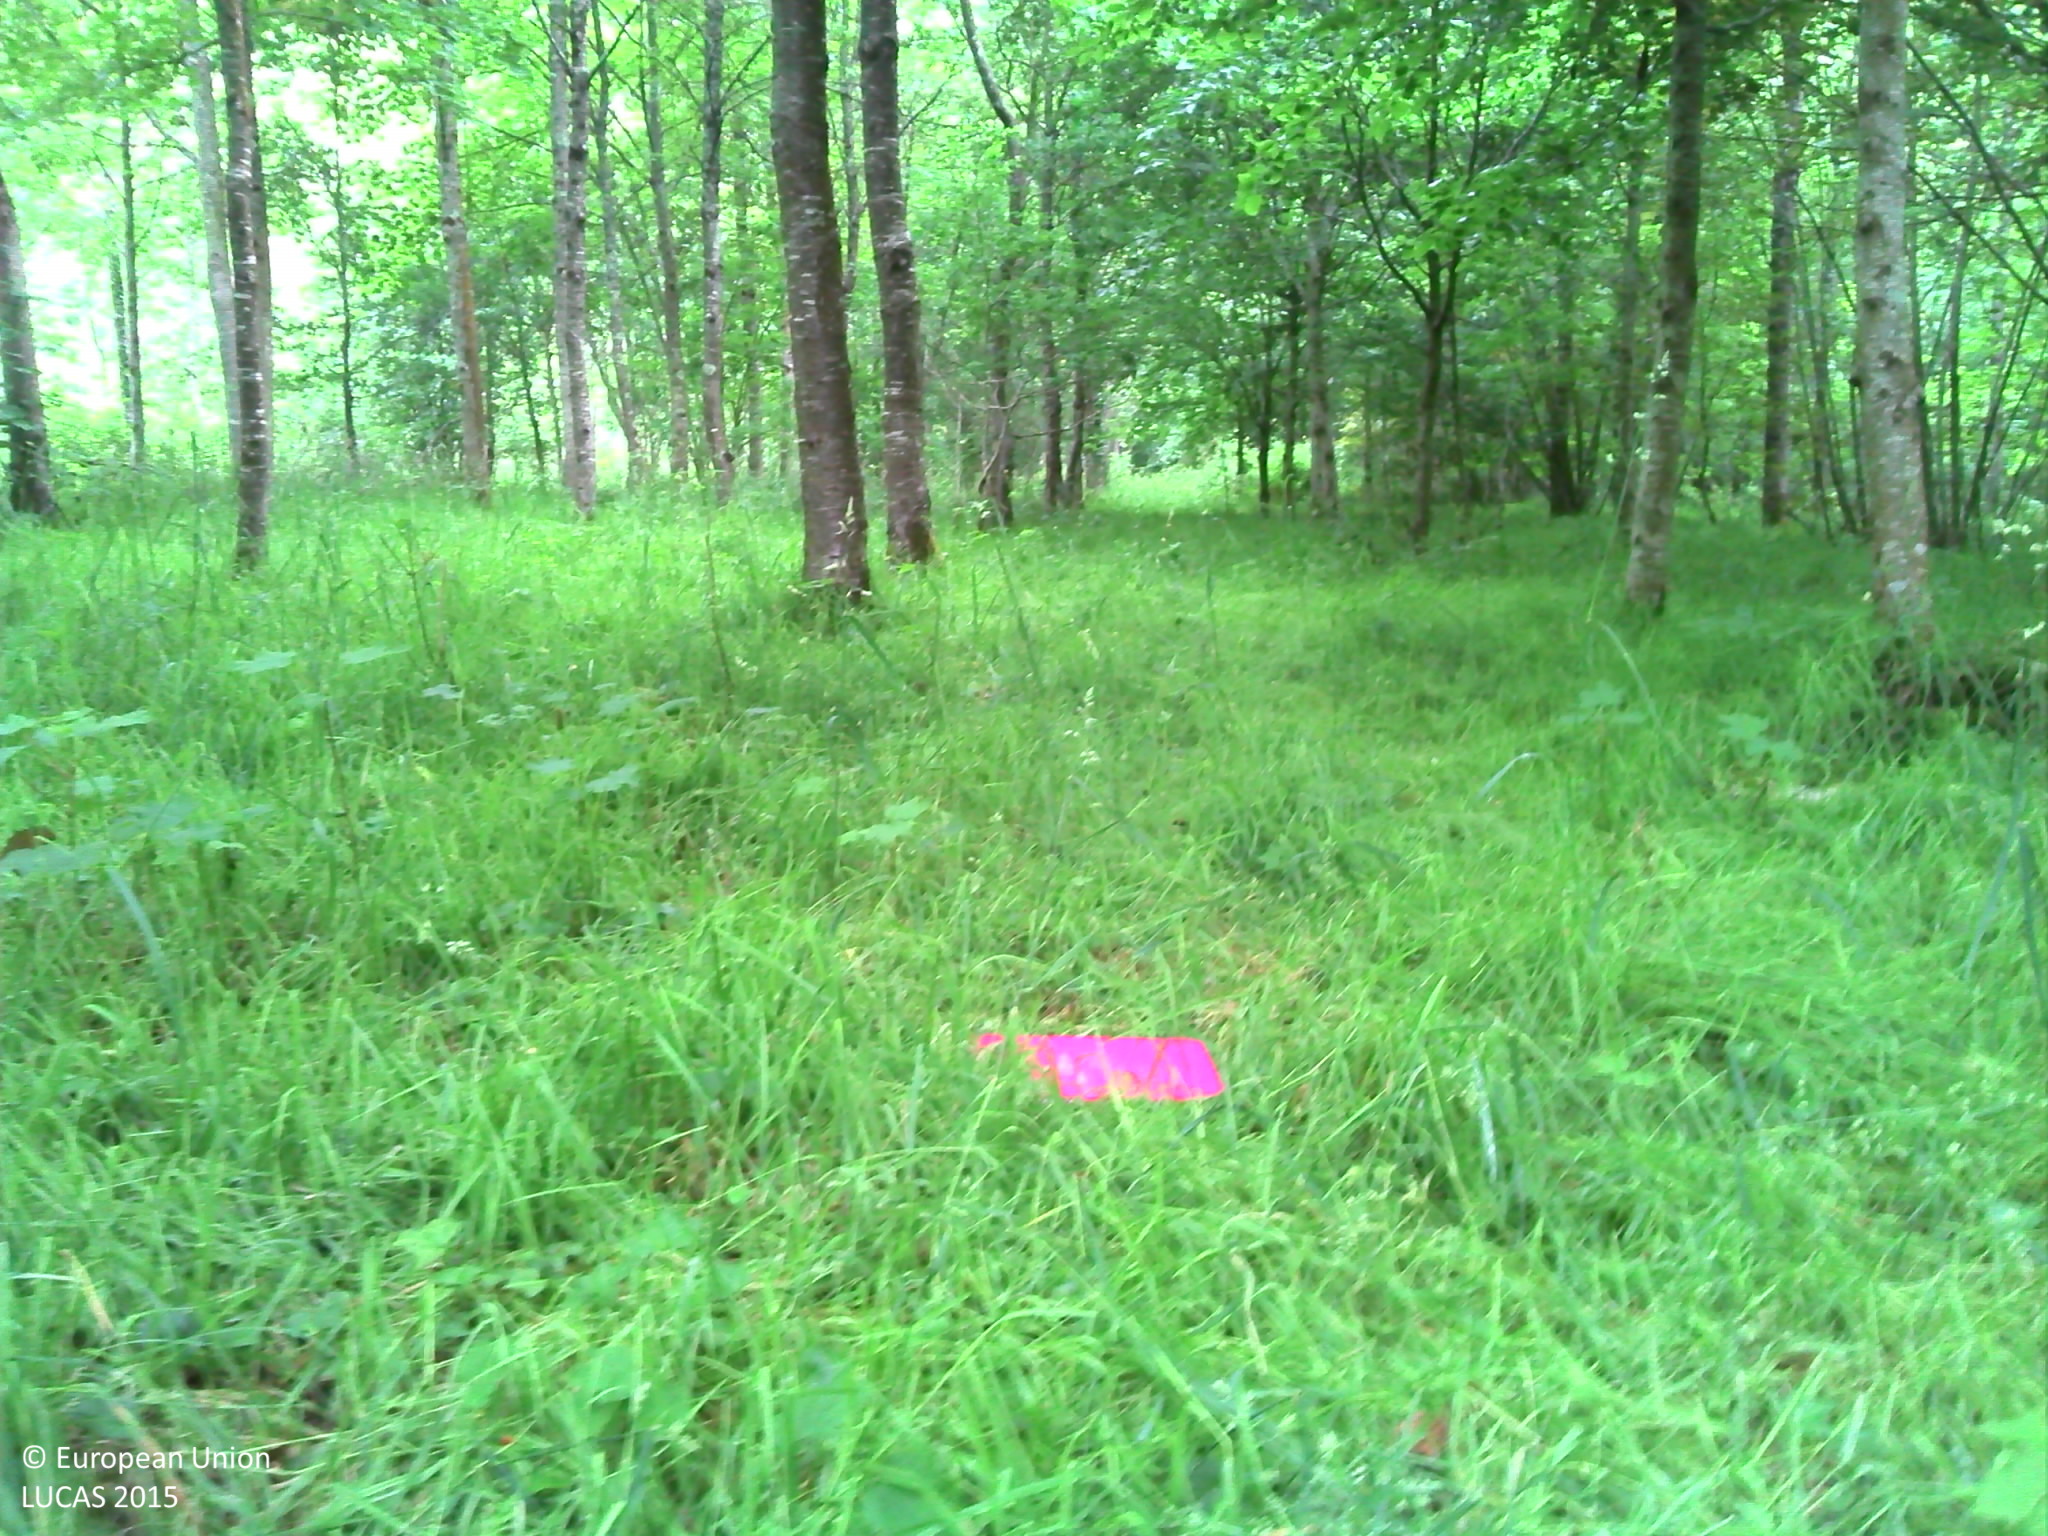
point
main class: Woodland
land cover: Broadleaved woodland
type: acidophilous oak and oak-birch forest
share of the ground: > 75 %
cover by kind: broadleaved forest trees 85 %, herbaceous plants 15 %
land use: Forestry
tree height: > 5 m
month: June
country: FR
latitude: 48.4392
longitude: -1.8251
